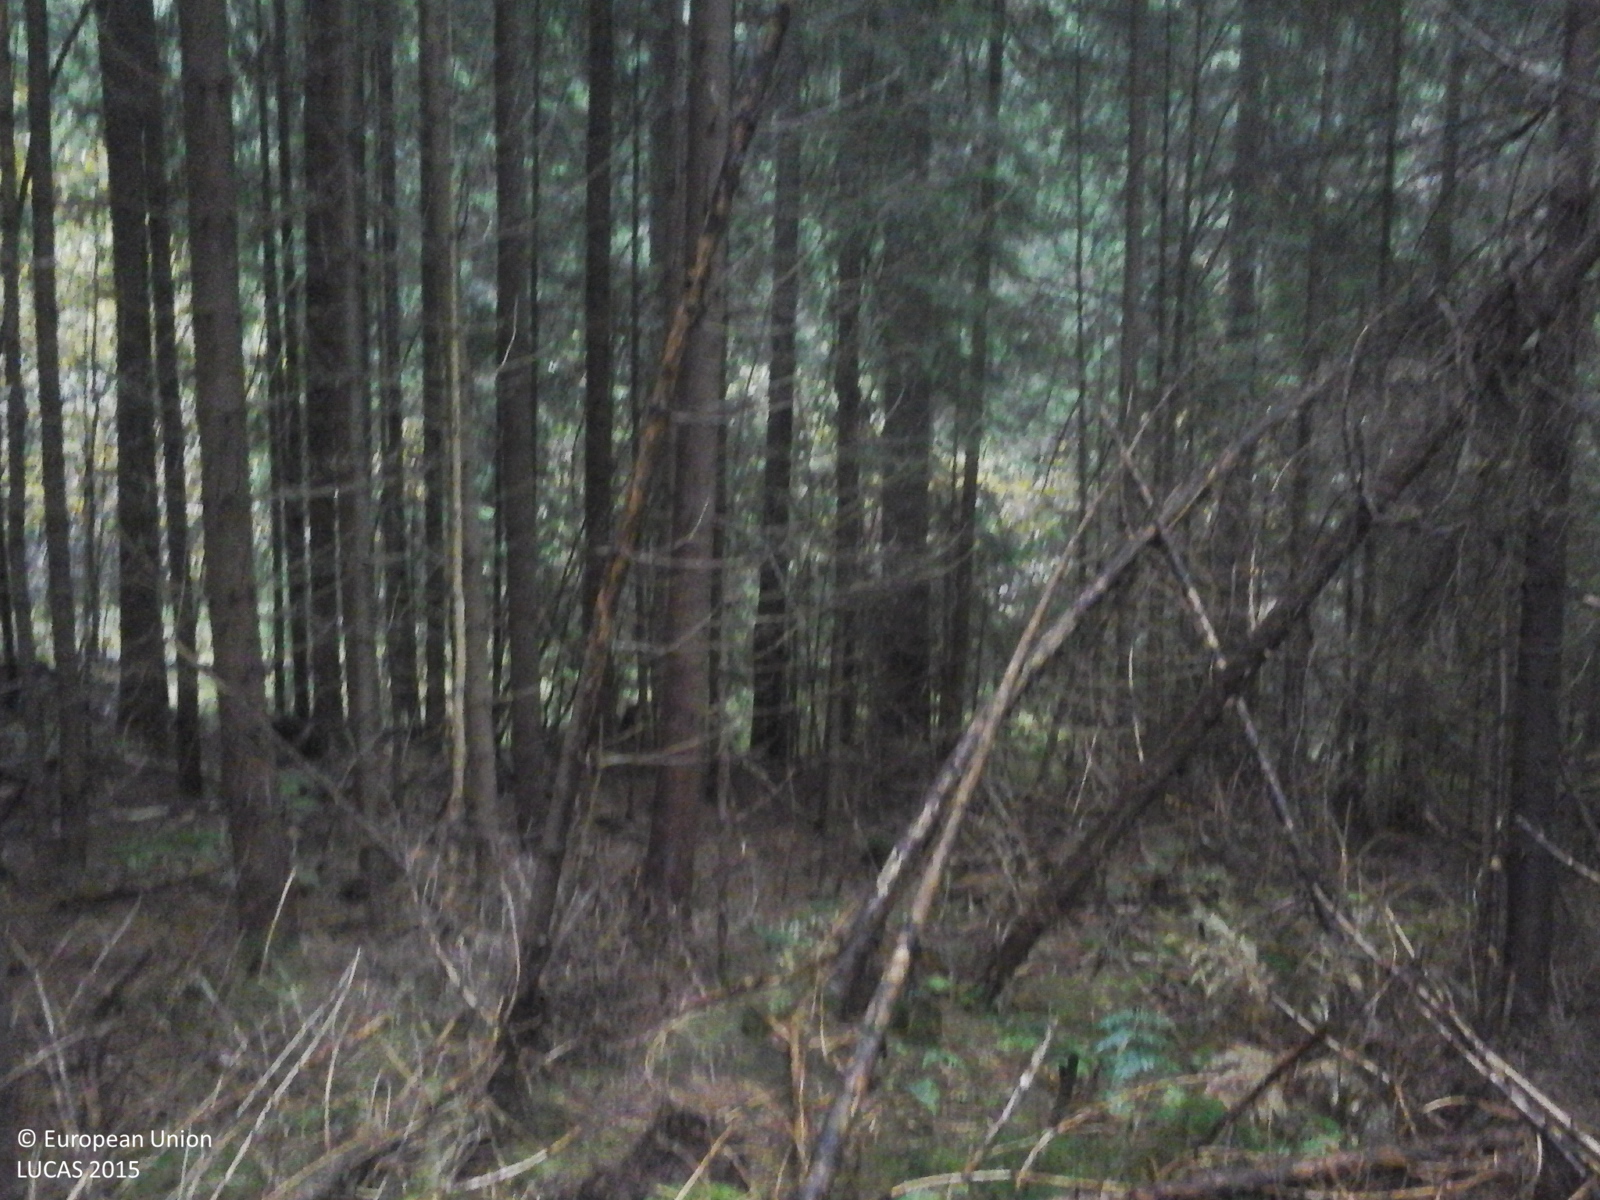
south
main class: Woodland
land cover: Spruce dominated coniferous woodland
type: alpine coniferous forest
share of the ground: > 75 %
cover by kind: coniferous forest trees 100 %
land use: Forestry
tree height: > 5 m
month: October
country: RO
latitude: 46.8291
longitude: 25.2200
